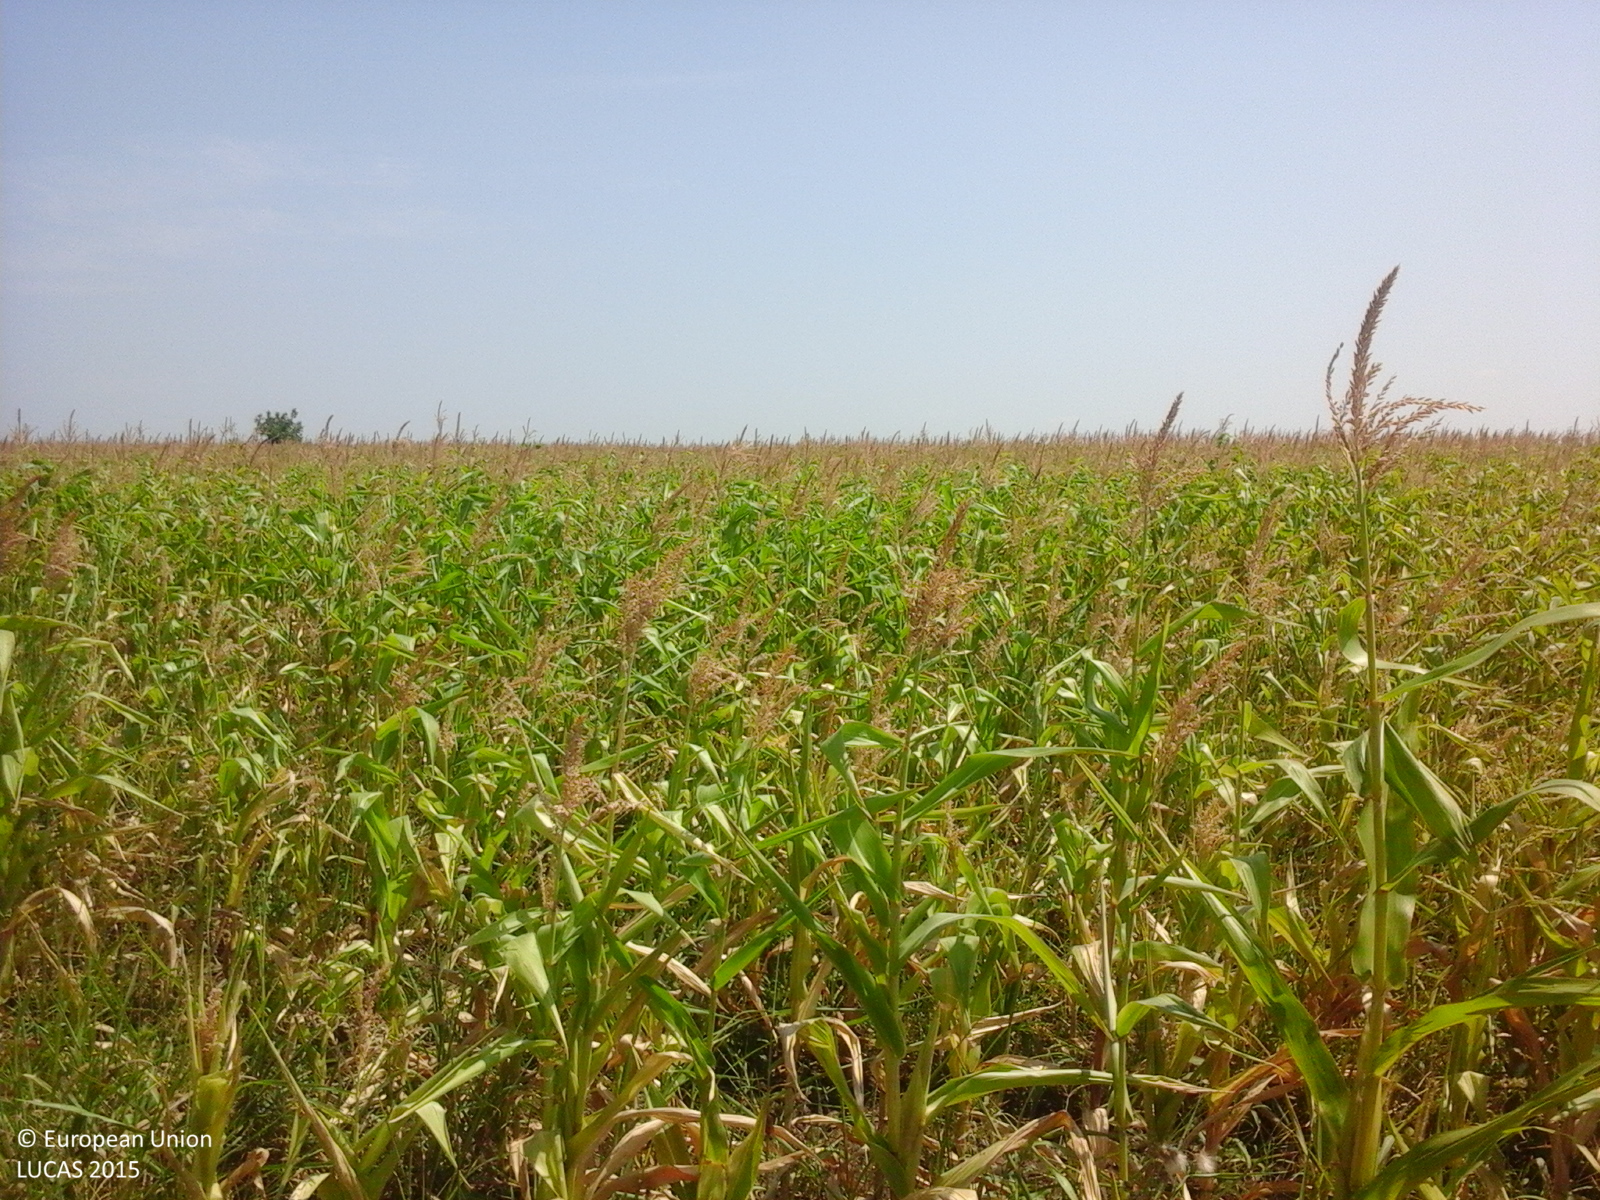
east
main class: Cropland
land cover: Maize
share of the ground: > 75 %
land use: Agriculture (excluding fallow land and kitchen gardens)
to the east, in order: Maize; Common wheat; Grass margins; Tracks; Spontaneously vegetated surfaces; Tracks
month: August
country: RO
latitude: 44.9756
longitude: 26.6731
